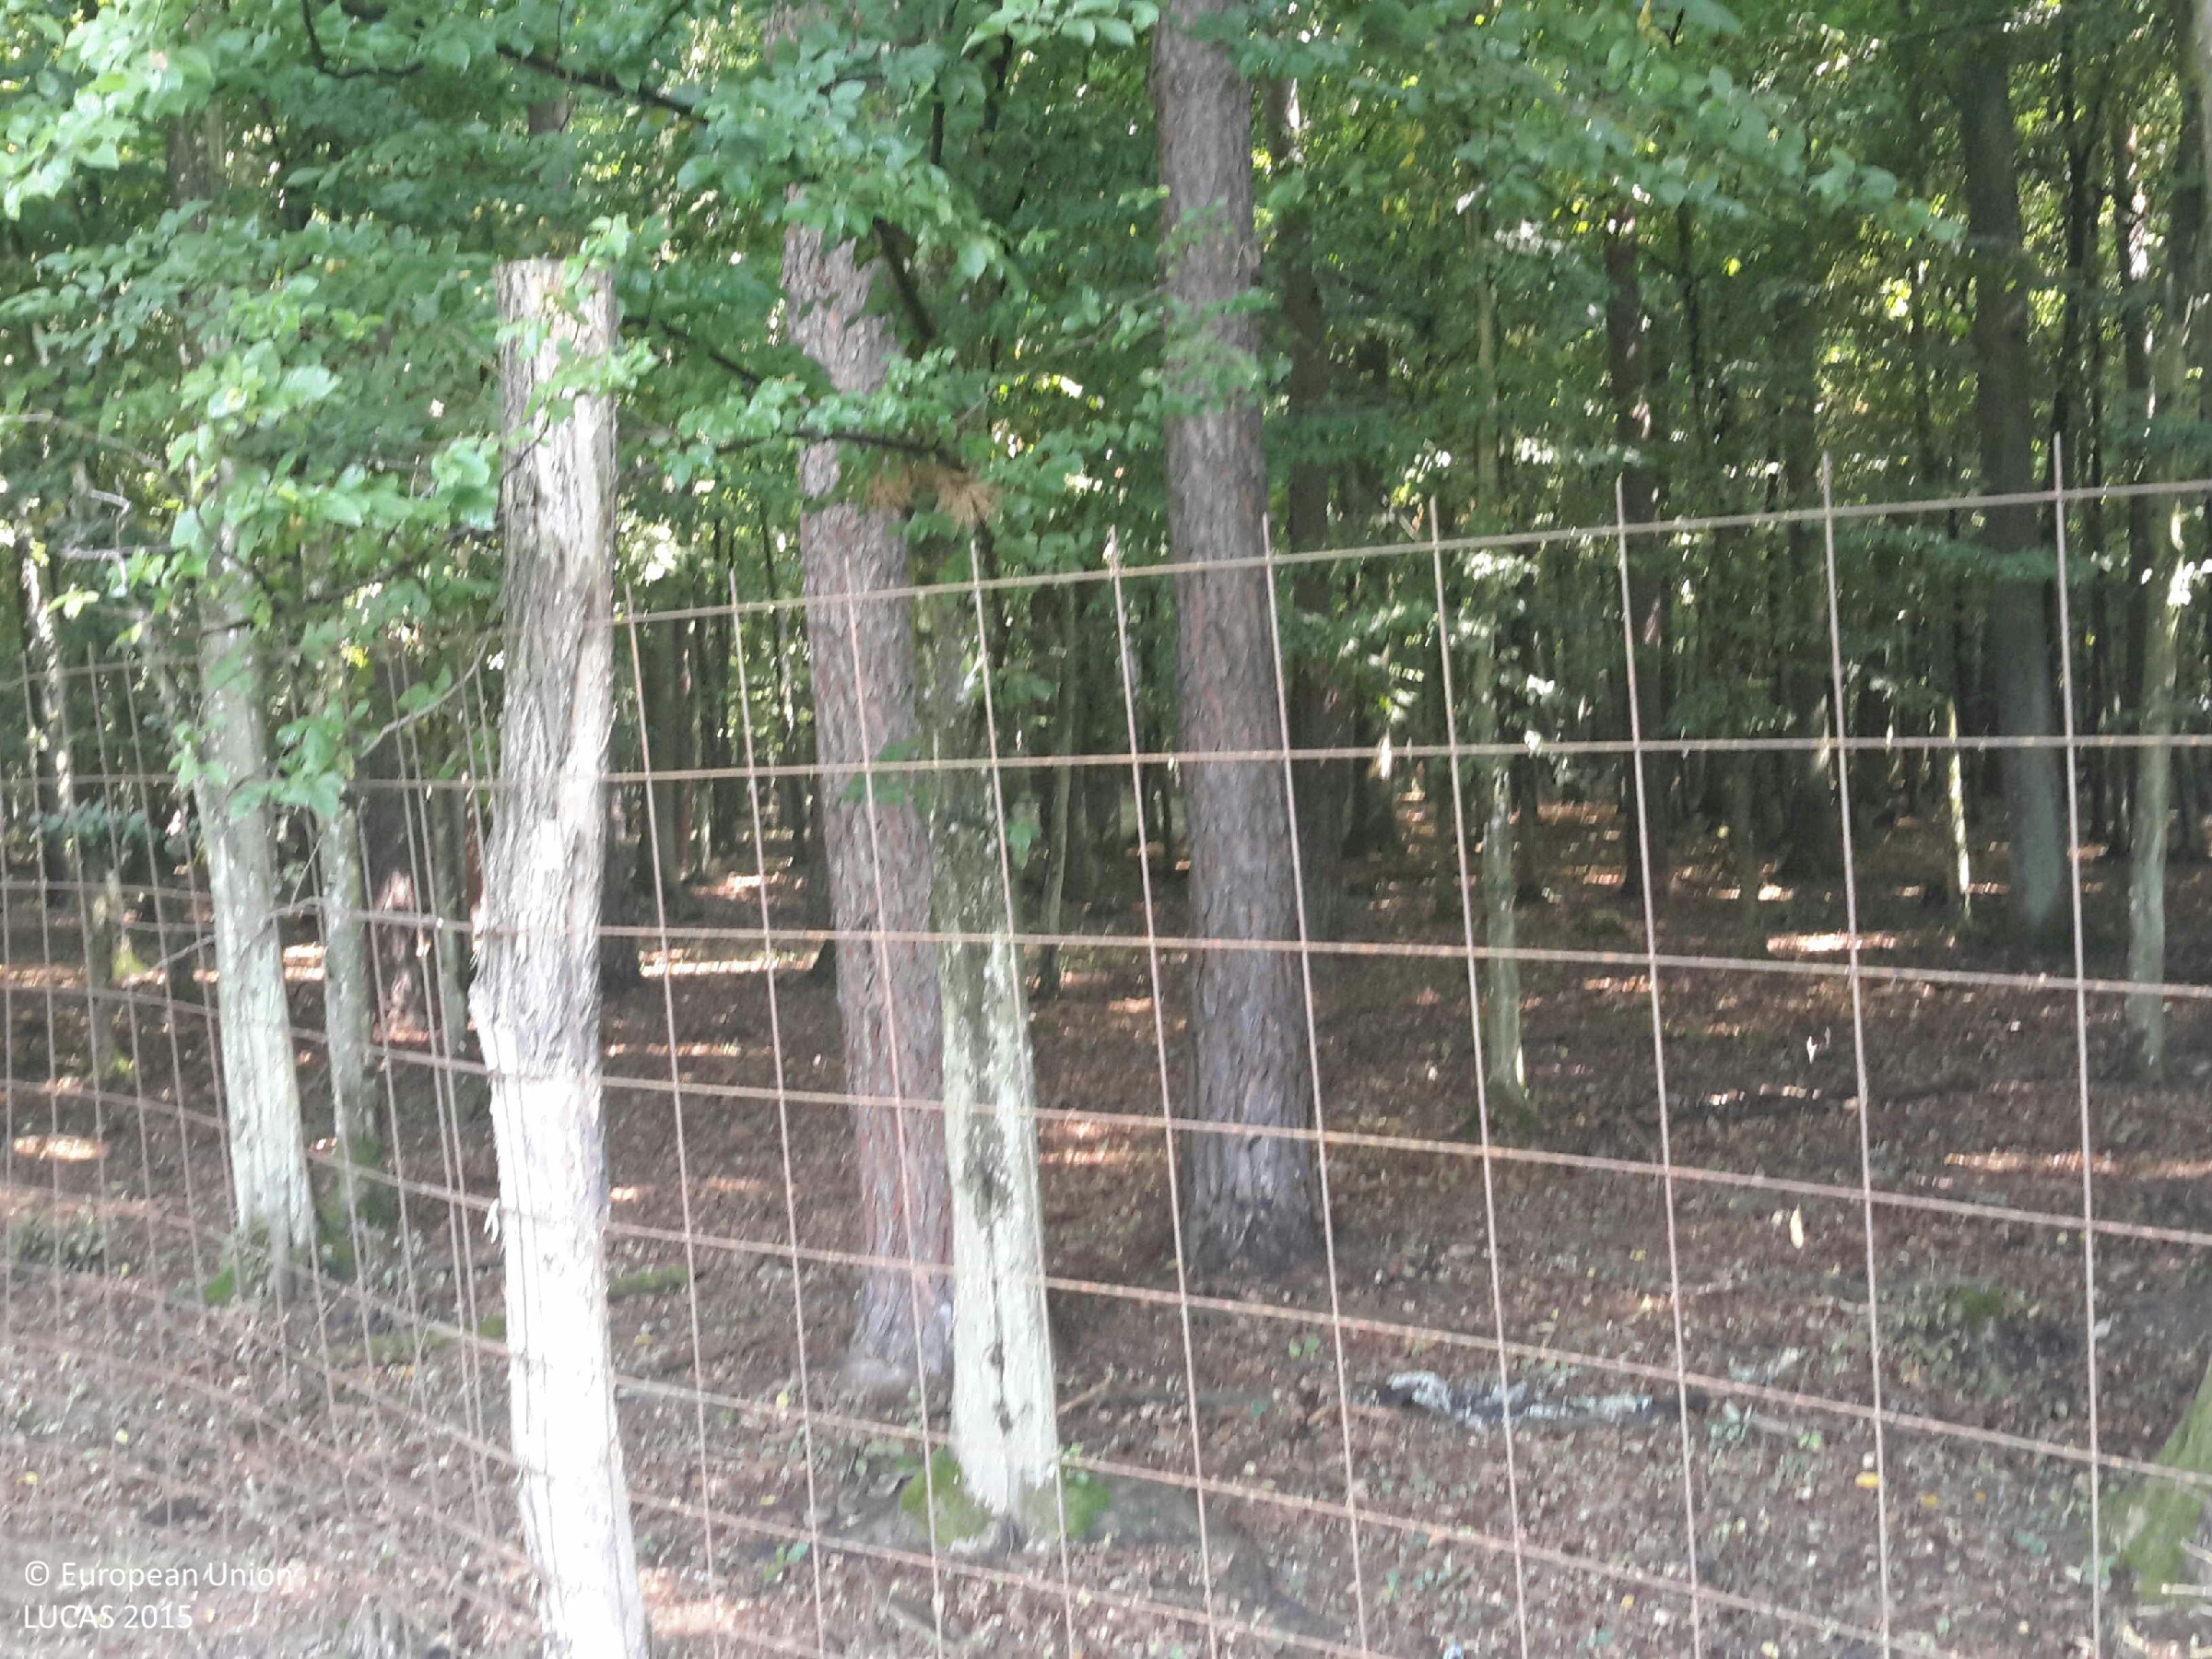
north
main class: Woodland
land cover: Broadleaved woodland
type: beech forest
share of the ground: > 75 %
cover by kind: broadleaved forest trees 90 %, herbaceous plants 10 %
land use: Forestry
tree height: > 5 m
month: August
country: HU
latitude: 47.1093
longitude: 16.5260
